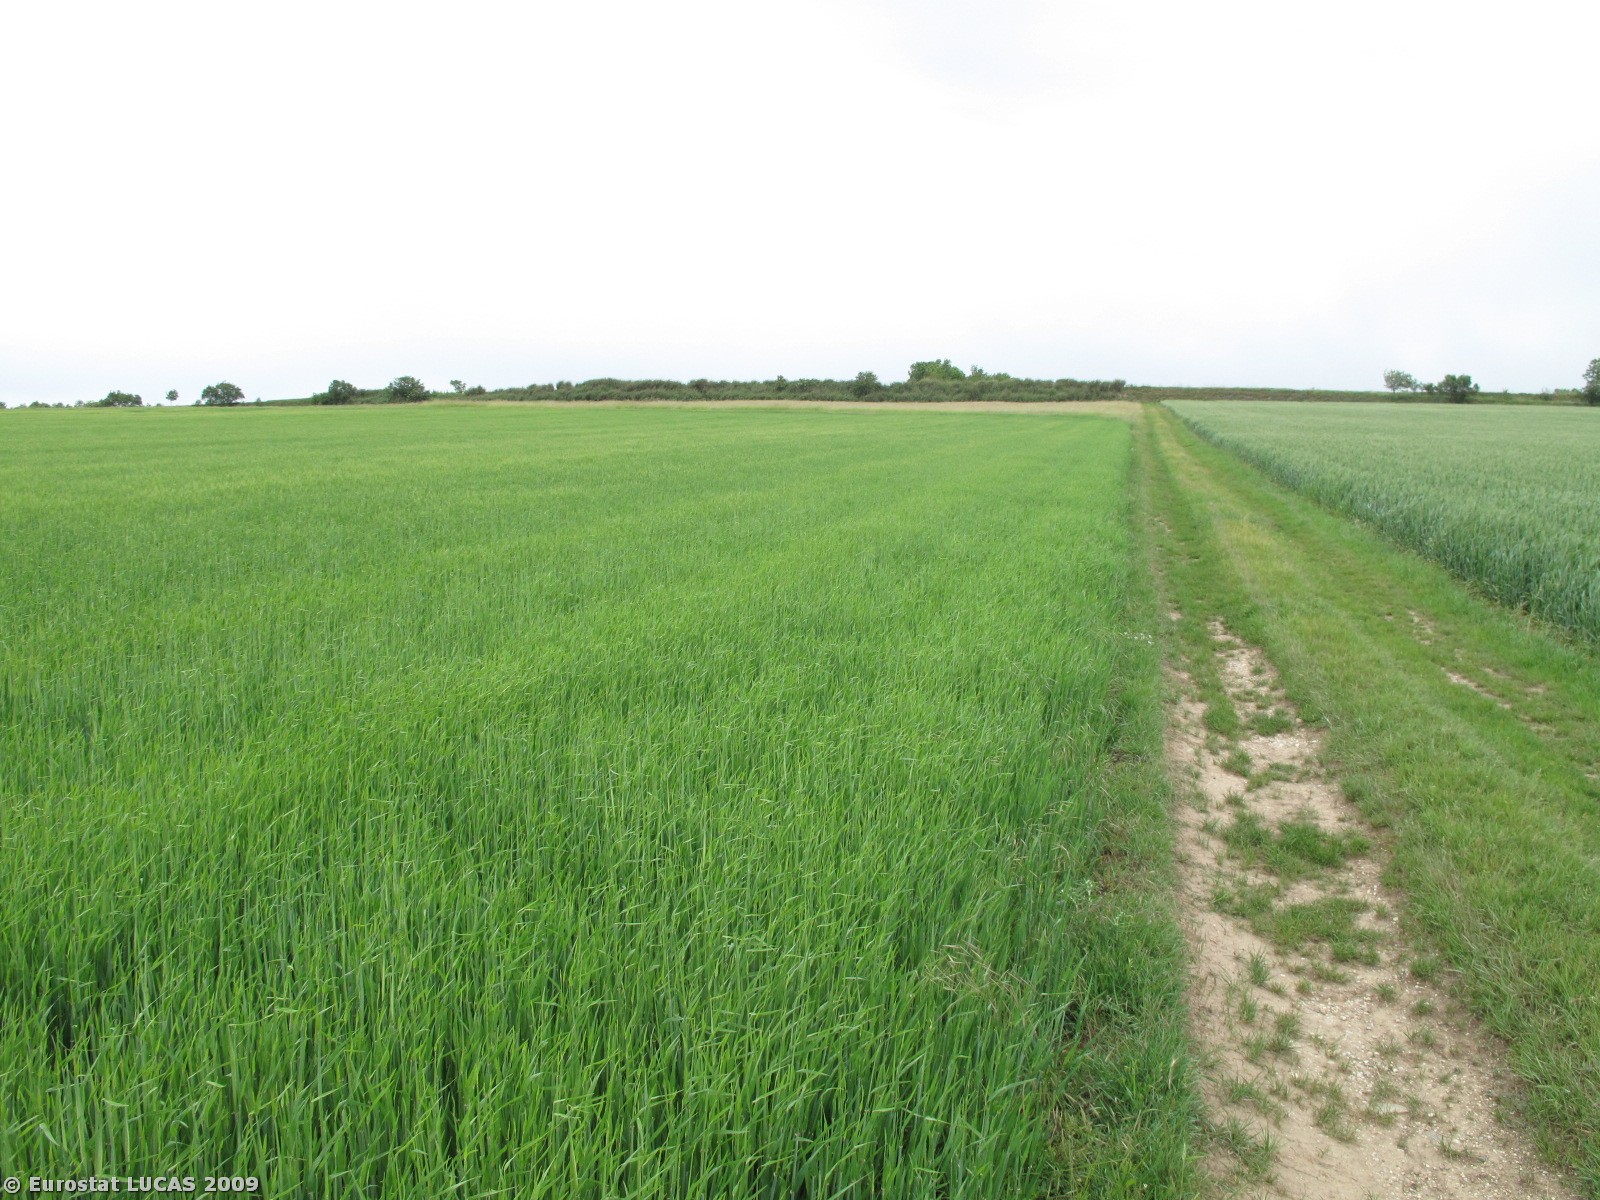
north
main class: Cropland
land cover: Barley
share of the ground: > 75 %
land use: Agriculture (excluding fallow land and kitchen gardens)
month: May
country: AT
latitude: 48.6366
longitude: 16.0161
